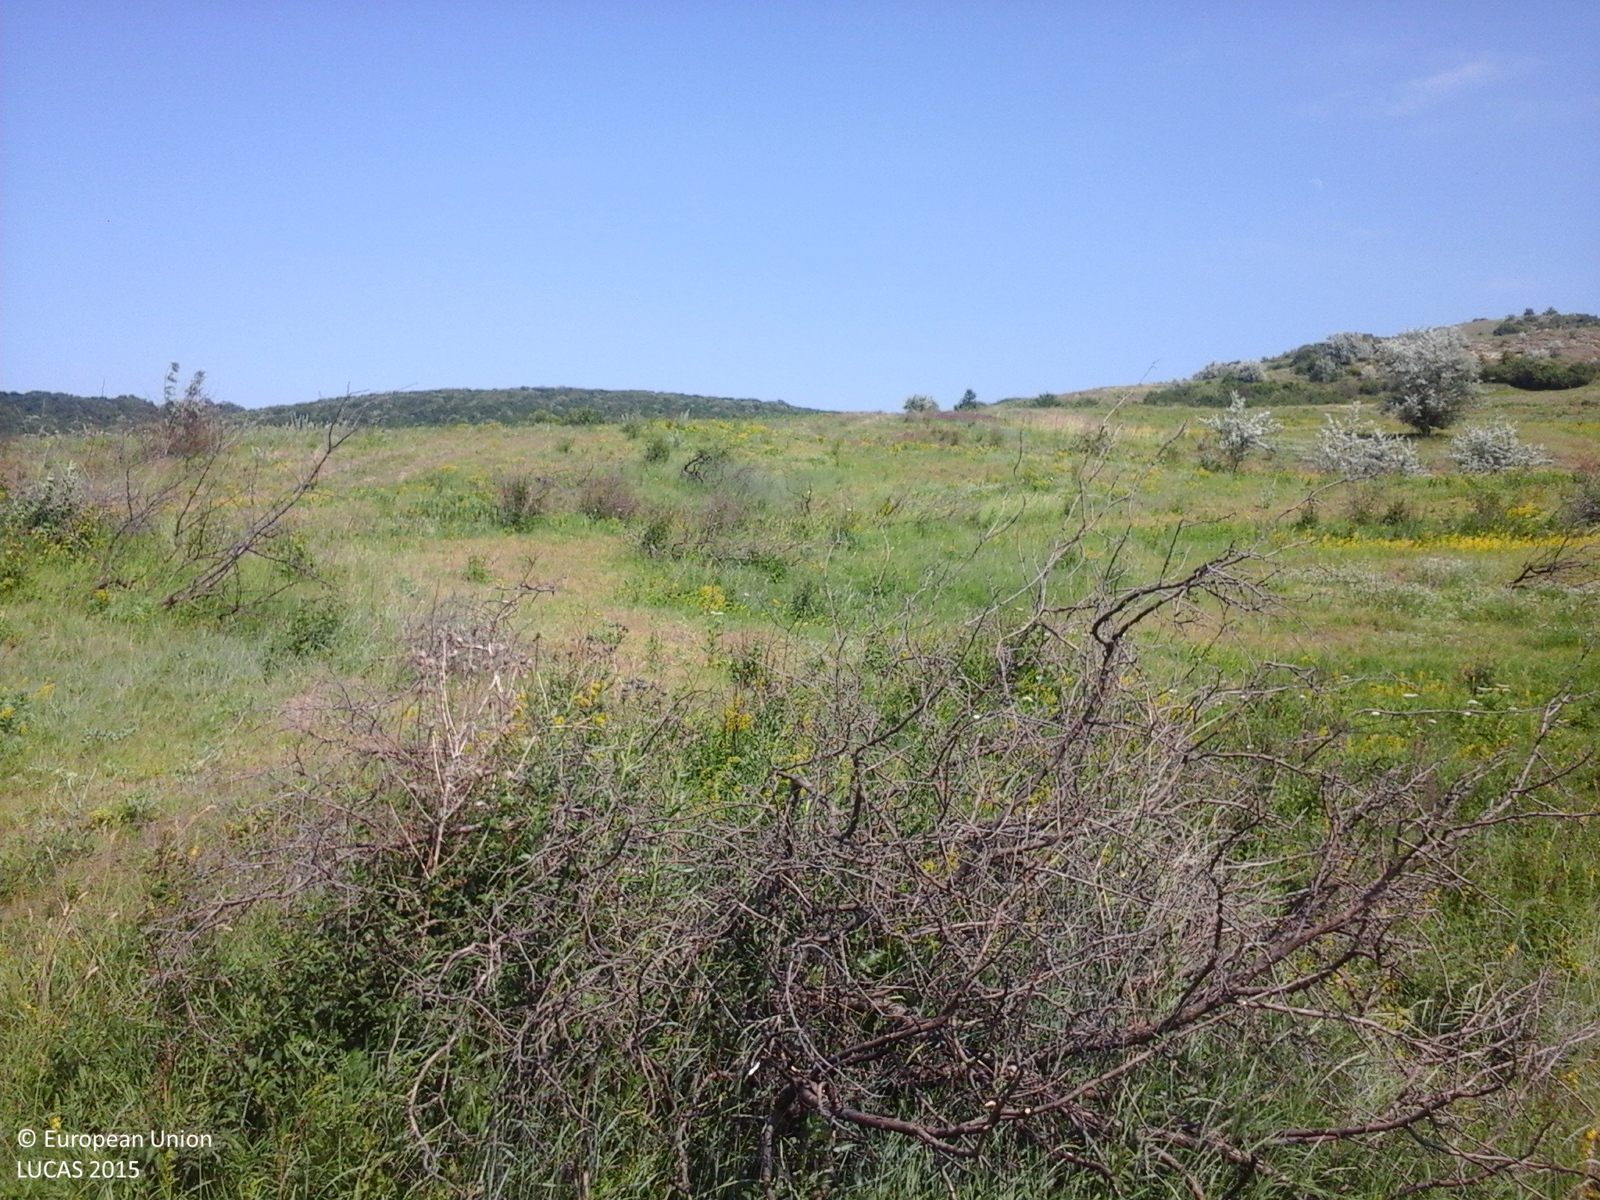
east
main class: Grassland
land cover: Grassland with sparse tree/shrub cover
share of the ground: 25 - 50 %
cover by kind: herbaceous plants 90 %, broadleaved forest trees 5 %, shrubs 5 %
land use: Agriculture (excluding fallow land and kitchen gardens)
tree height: < 5 m
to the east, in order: Grassland with sparse tree/shrub cover; Maize; Spontaneously vegetated surfaces; Maize; Shruby margins; Lines of trees; Shruby margins
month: June
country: RO
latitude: 46.7489
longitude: 27.9692
